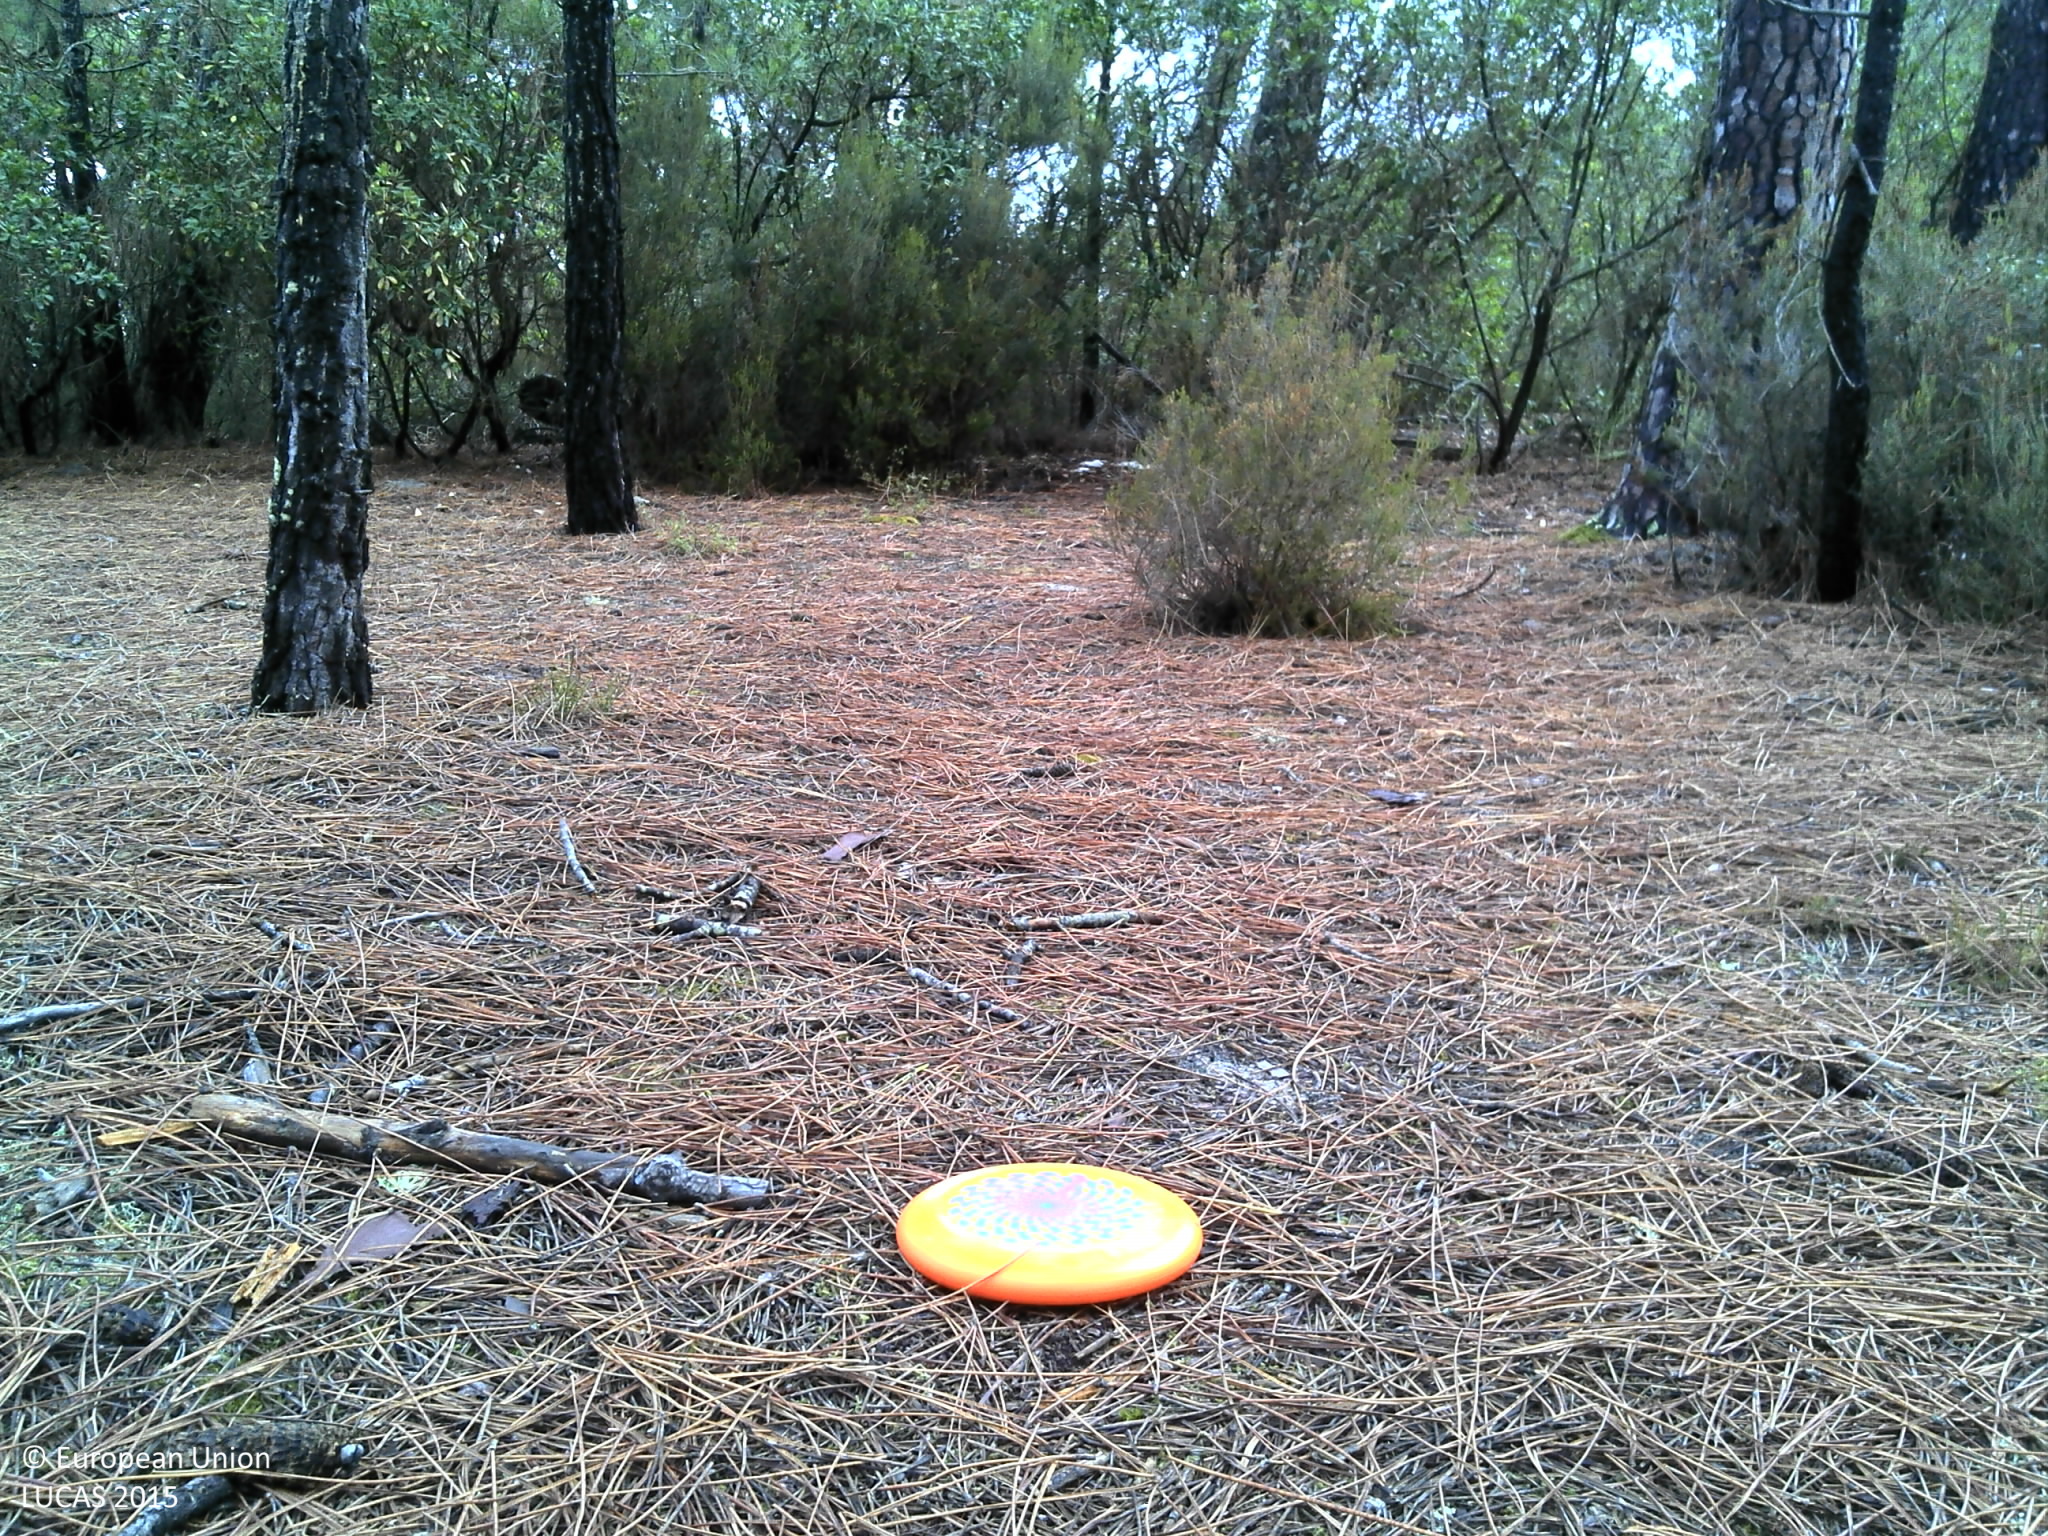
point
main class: Woodland
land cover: Pine dominated coniferous woodland
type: coniferous forest of the mediterranean region
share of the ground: > 75 %
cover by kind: coniferous forest trees 60 %, shrubs 30 %, herbaceous plants 5 %, lichens and mosses 5 %
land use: Forestry
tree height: > 5 m
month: July
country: FR
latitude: 44.5566
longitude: -1.2403
